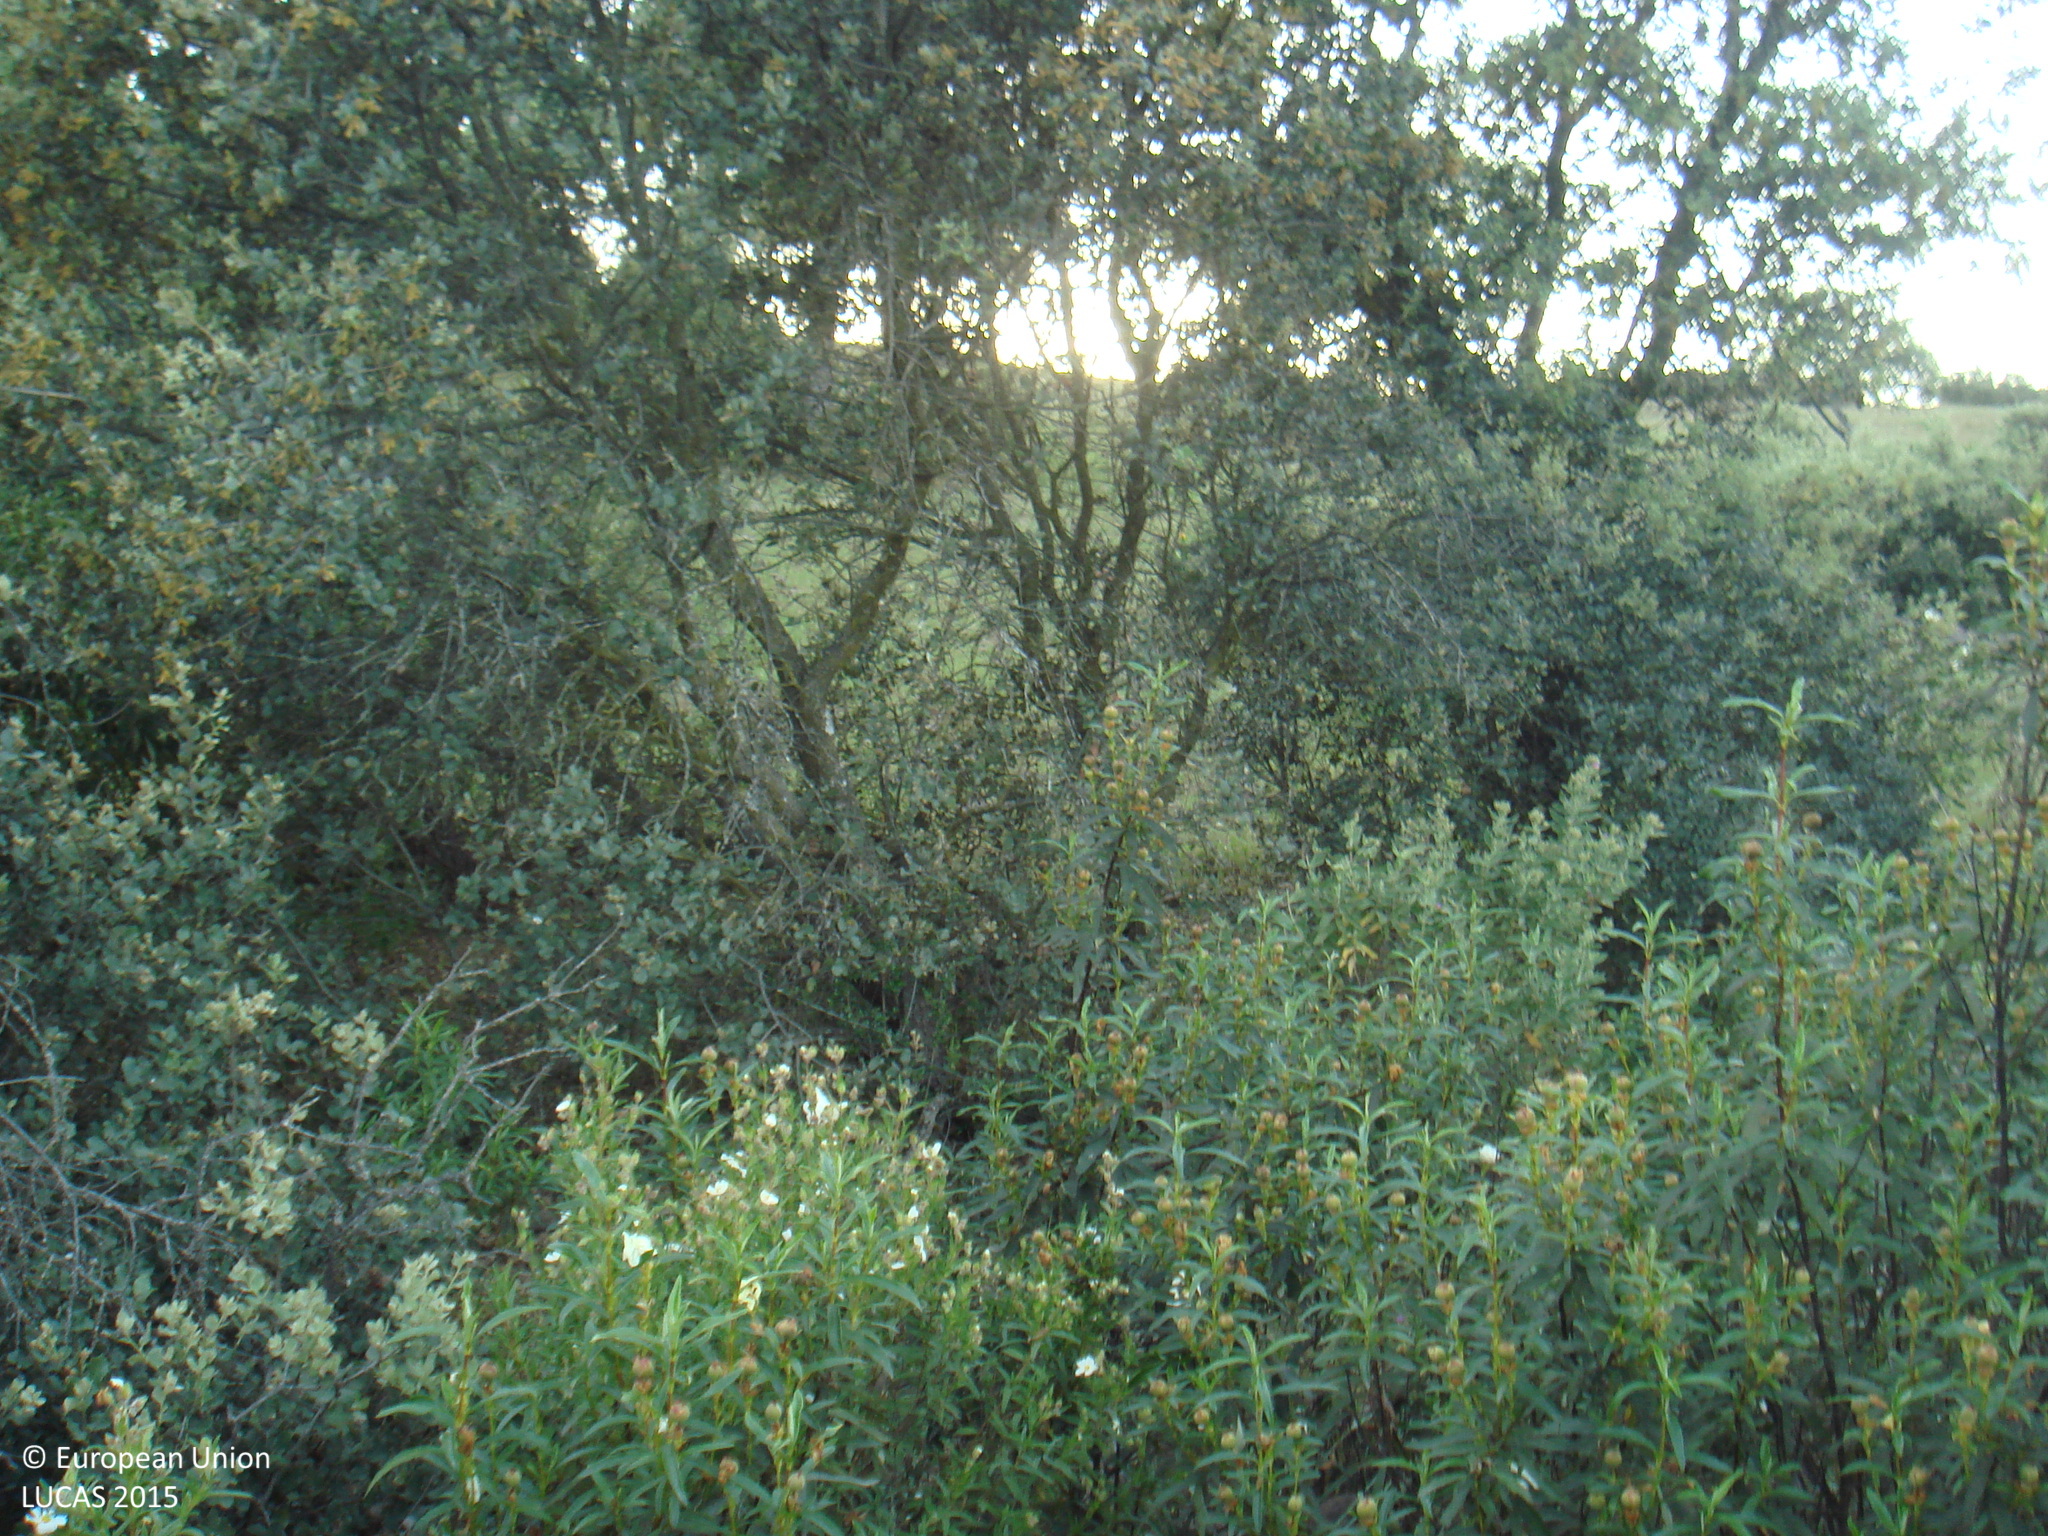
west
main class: Shrubland
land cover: Shrubland with sparse tree cover
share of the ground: 50 - 75 %
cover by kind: herbaceous plants 55 %, shrubs 40 %, broadleaved forest trees 5 %
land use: Forestry
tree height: > 5 m
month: April
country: ES
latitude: 38.0681
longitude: -4.7092
